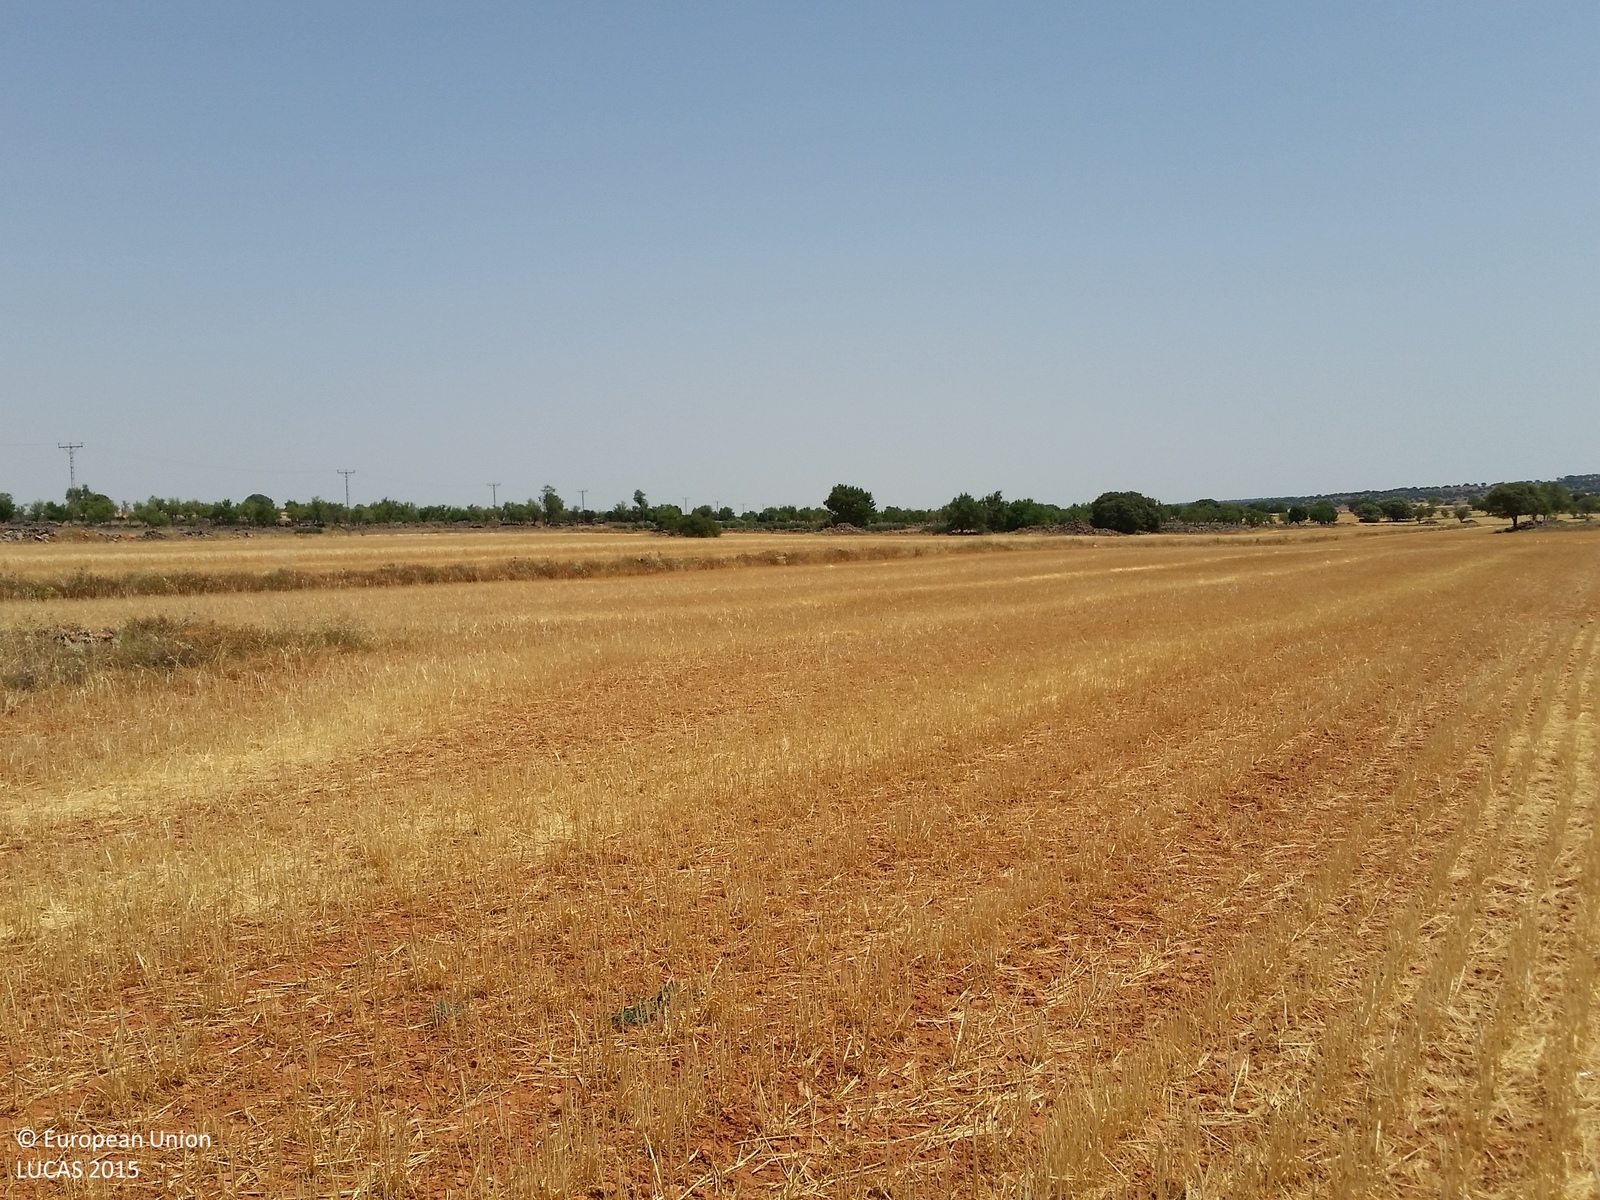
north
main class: Cropland
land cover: Barley
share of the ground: < 10 %
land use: Agriculture (excluding fallow land and kitchen gardens)
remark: Harvested field
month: June
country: ES
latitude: 38.7795
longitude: -2.5618
